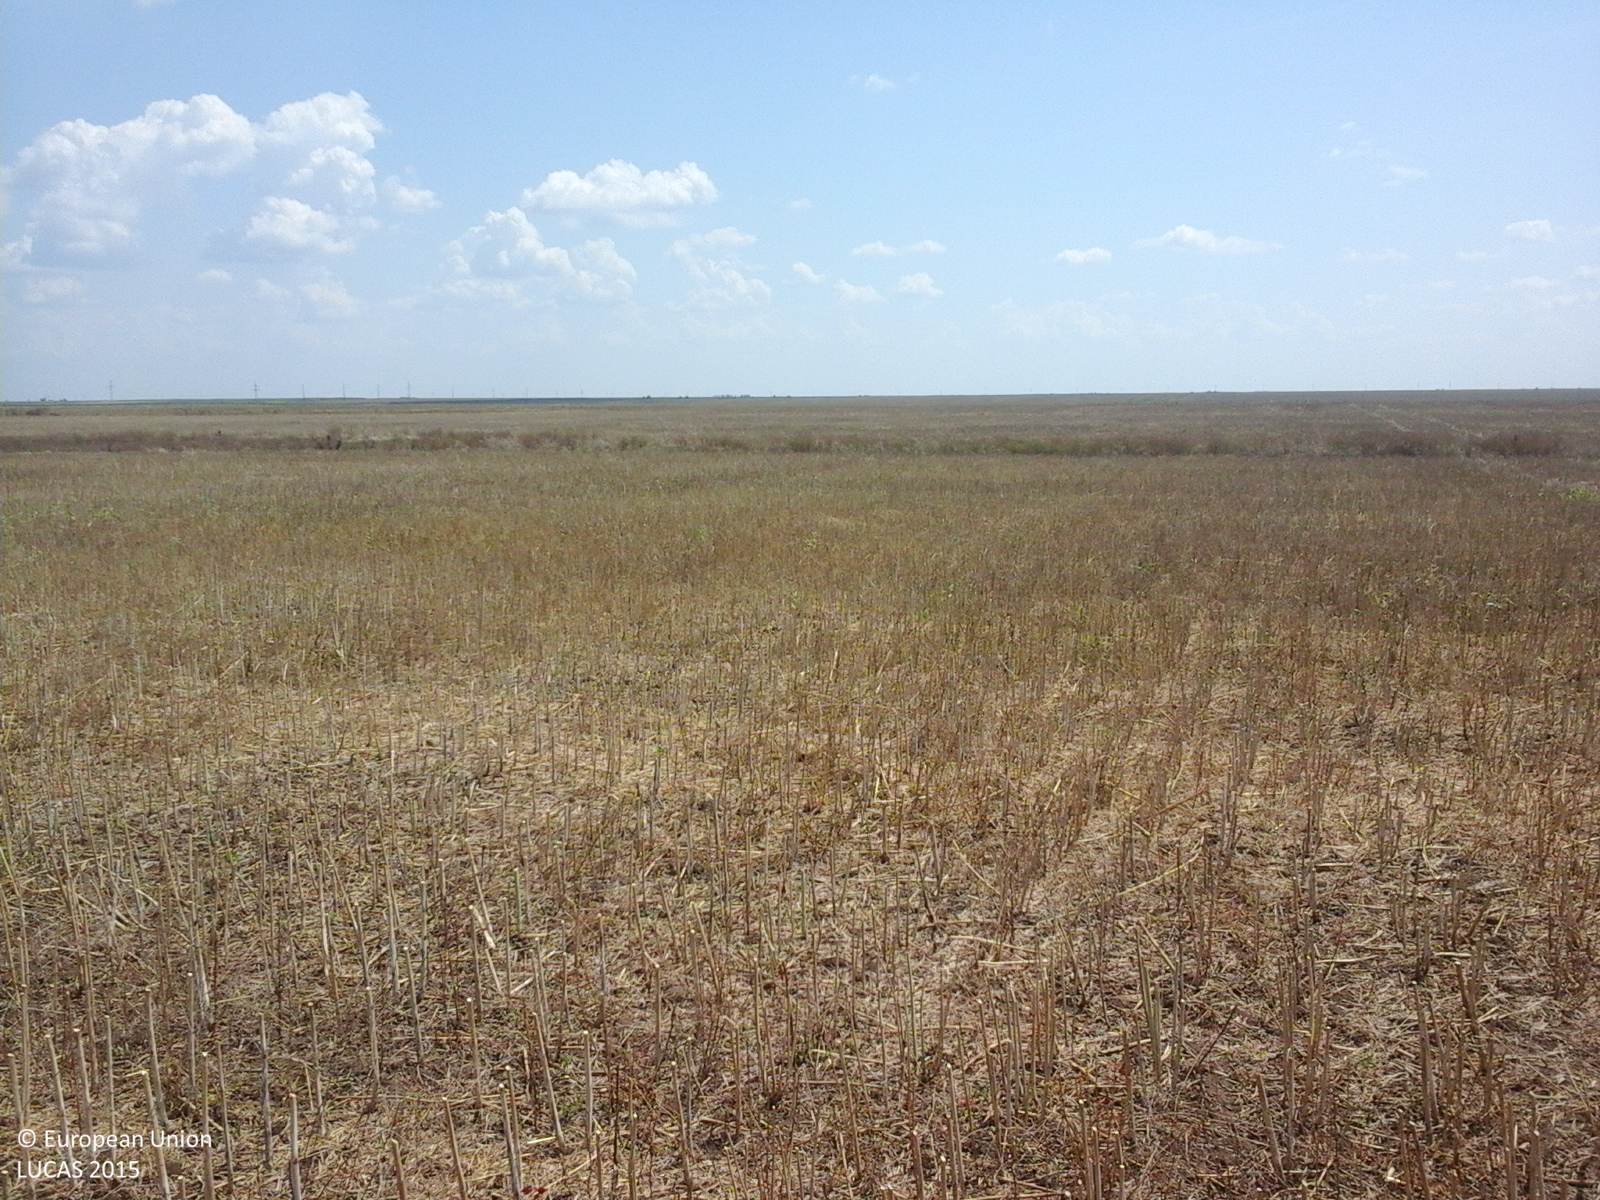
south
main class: Cropland
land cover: Rape and turnip rape
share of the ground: < 10 %
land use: Agriculture (excluding fallow land and kitchen gardens)
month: July
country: RO
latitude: 44.0380
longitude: 24.2507
